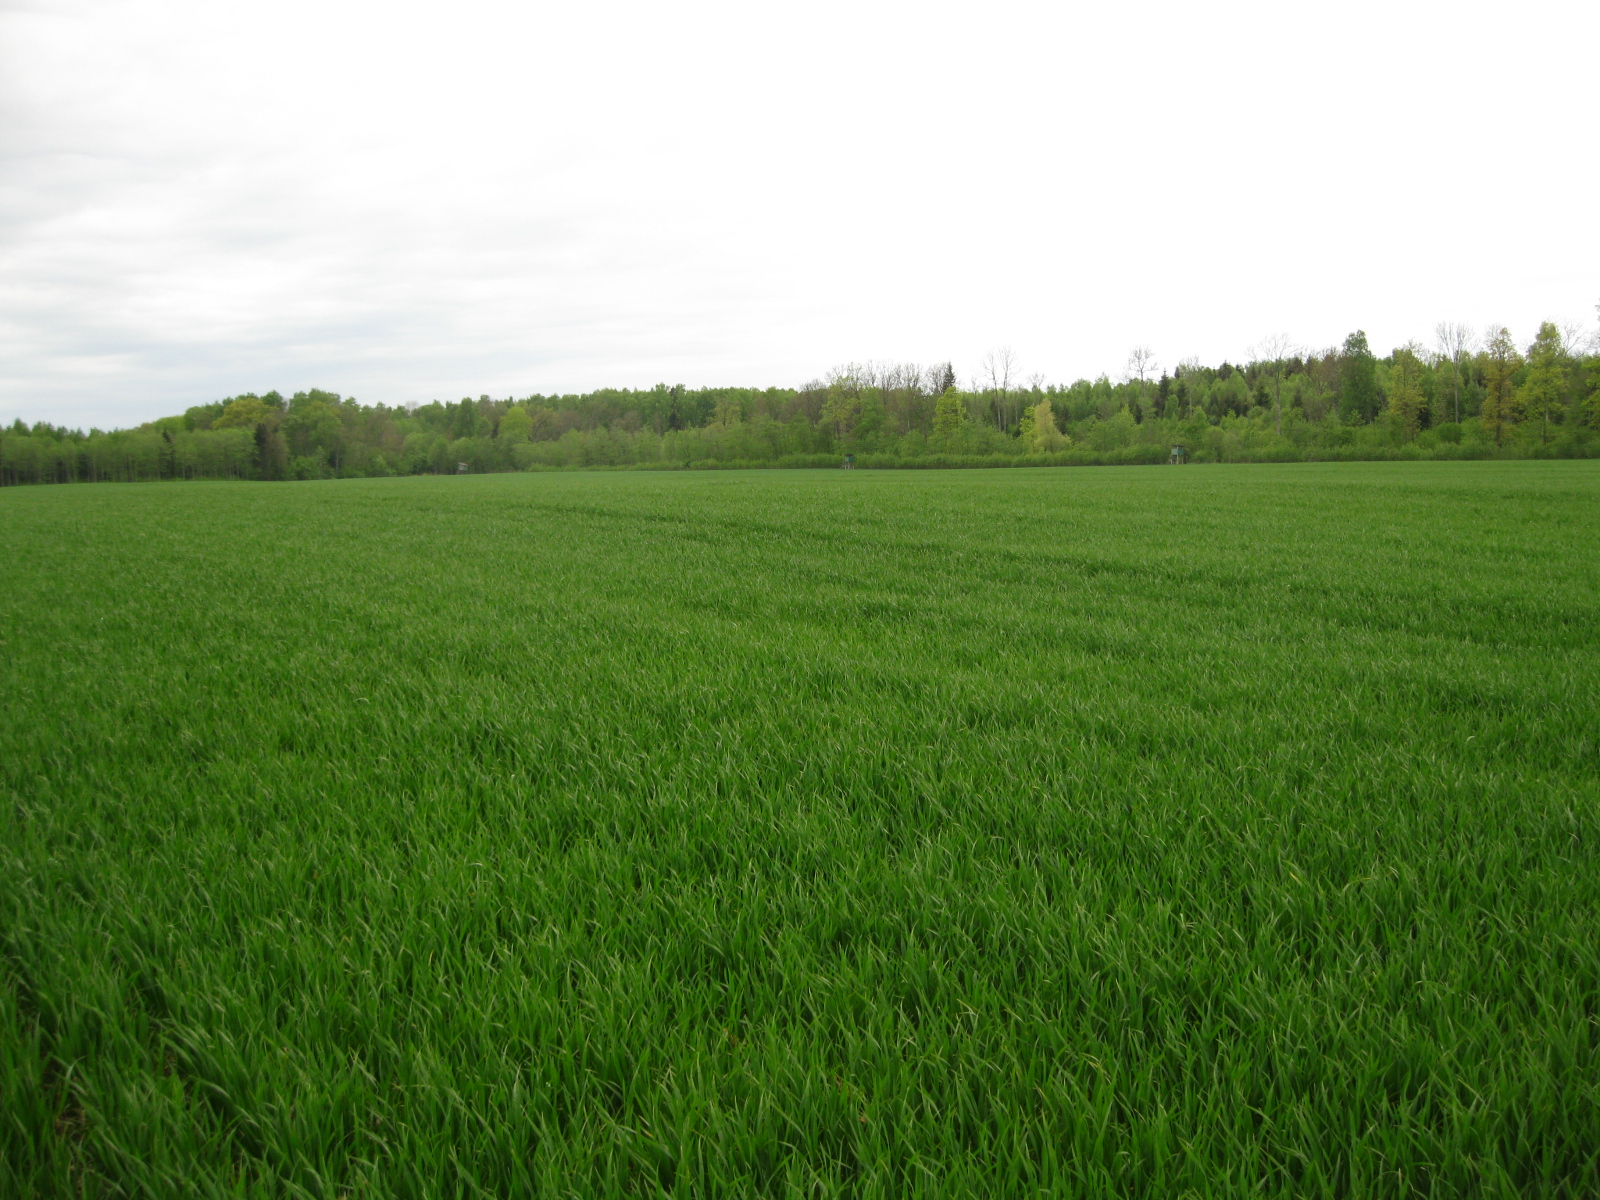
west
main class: Cropland
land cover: Barley
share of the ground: > 75 %
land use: Agriculture (excluding fallow land and kitchen gardens)
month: May
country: LT
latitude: 56.2101
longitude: 23.4078
